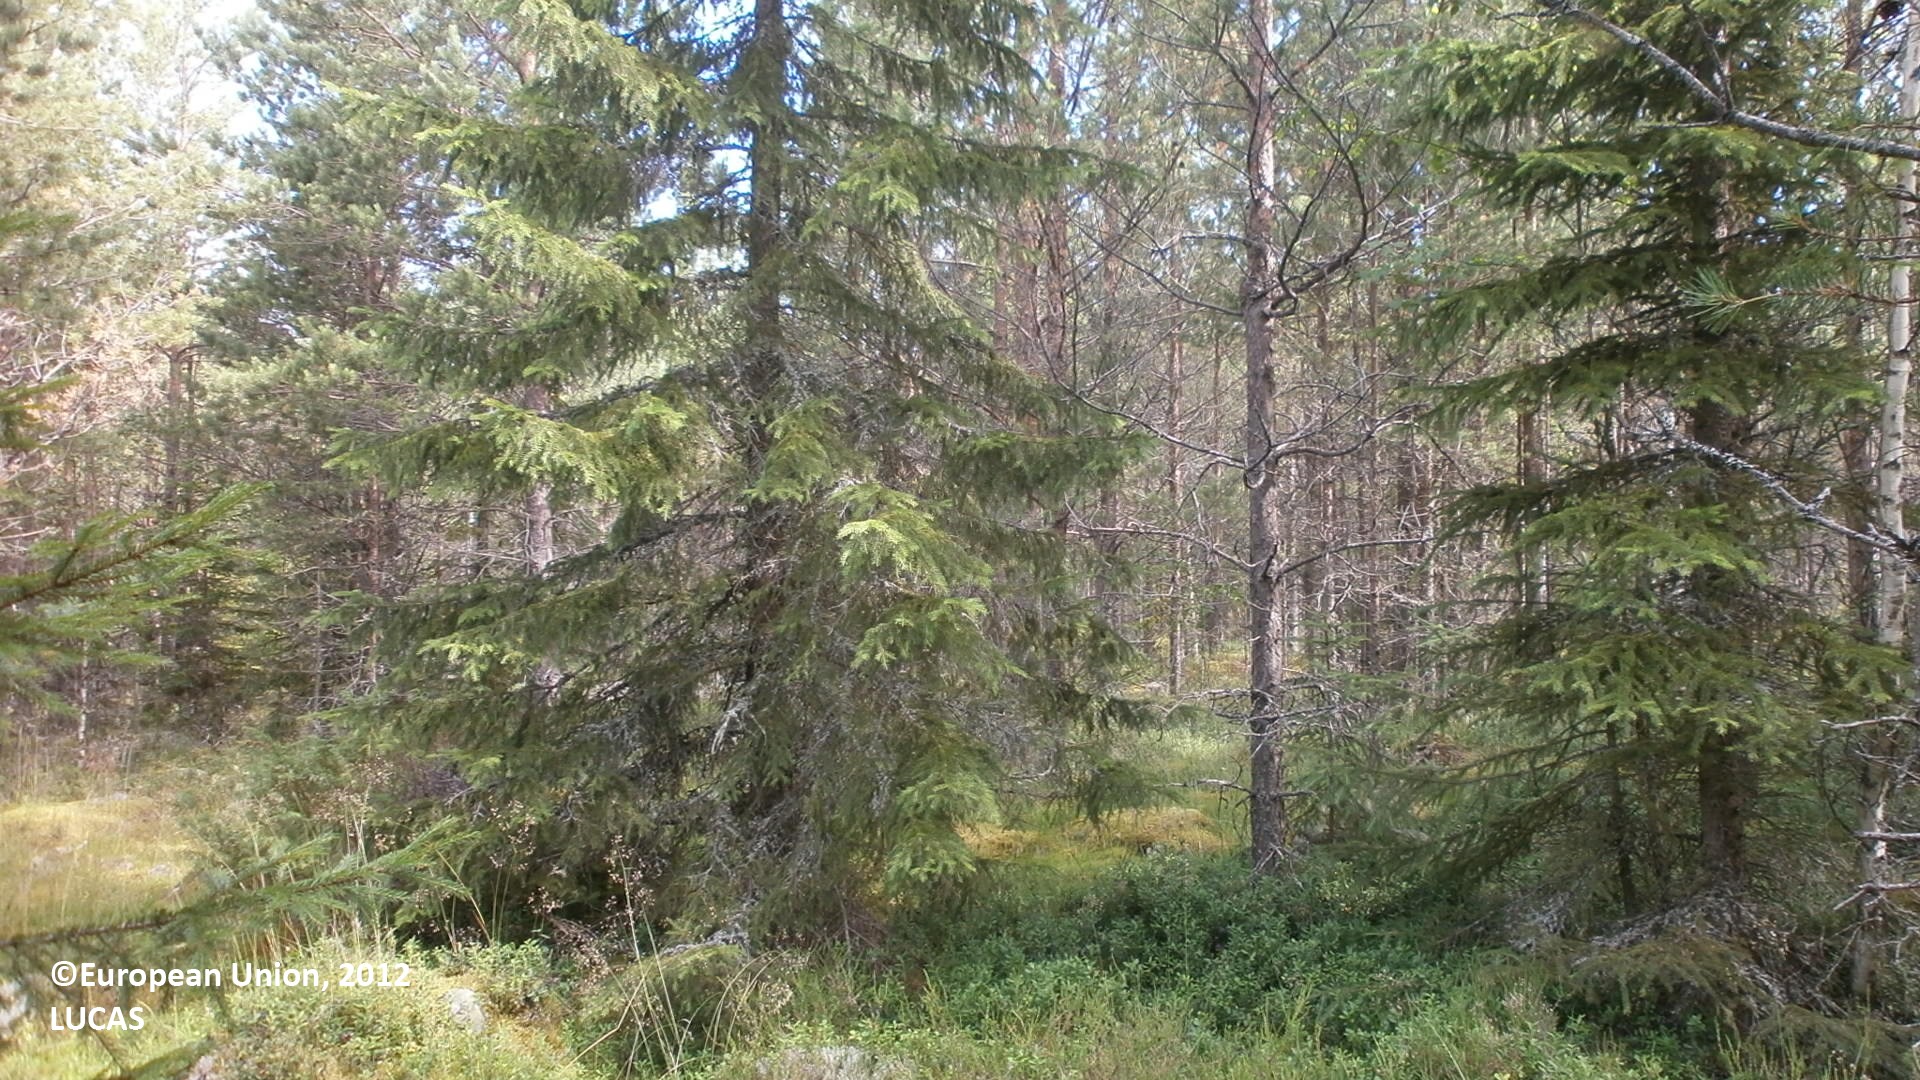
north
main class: Woodland
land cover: Pine dominated coniferous woodland
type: boreal forest
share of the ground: 50 - 75 %
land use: Forestry
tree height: > 5 m
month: July
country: FI
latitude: 64.0556
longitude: 23.9330
